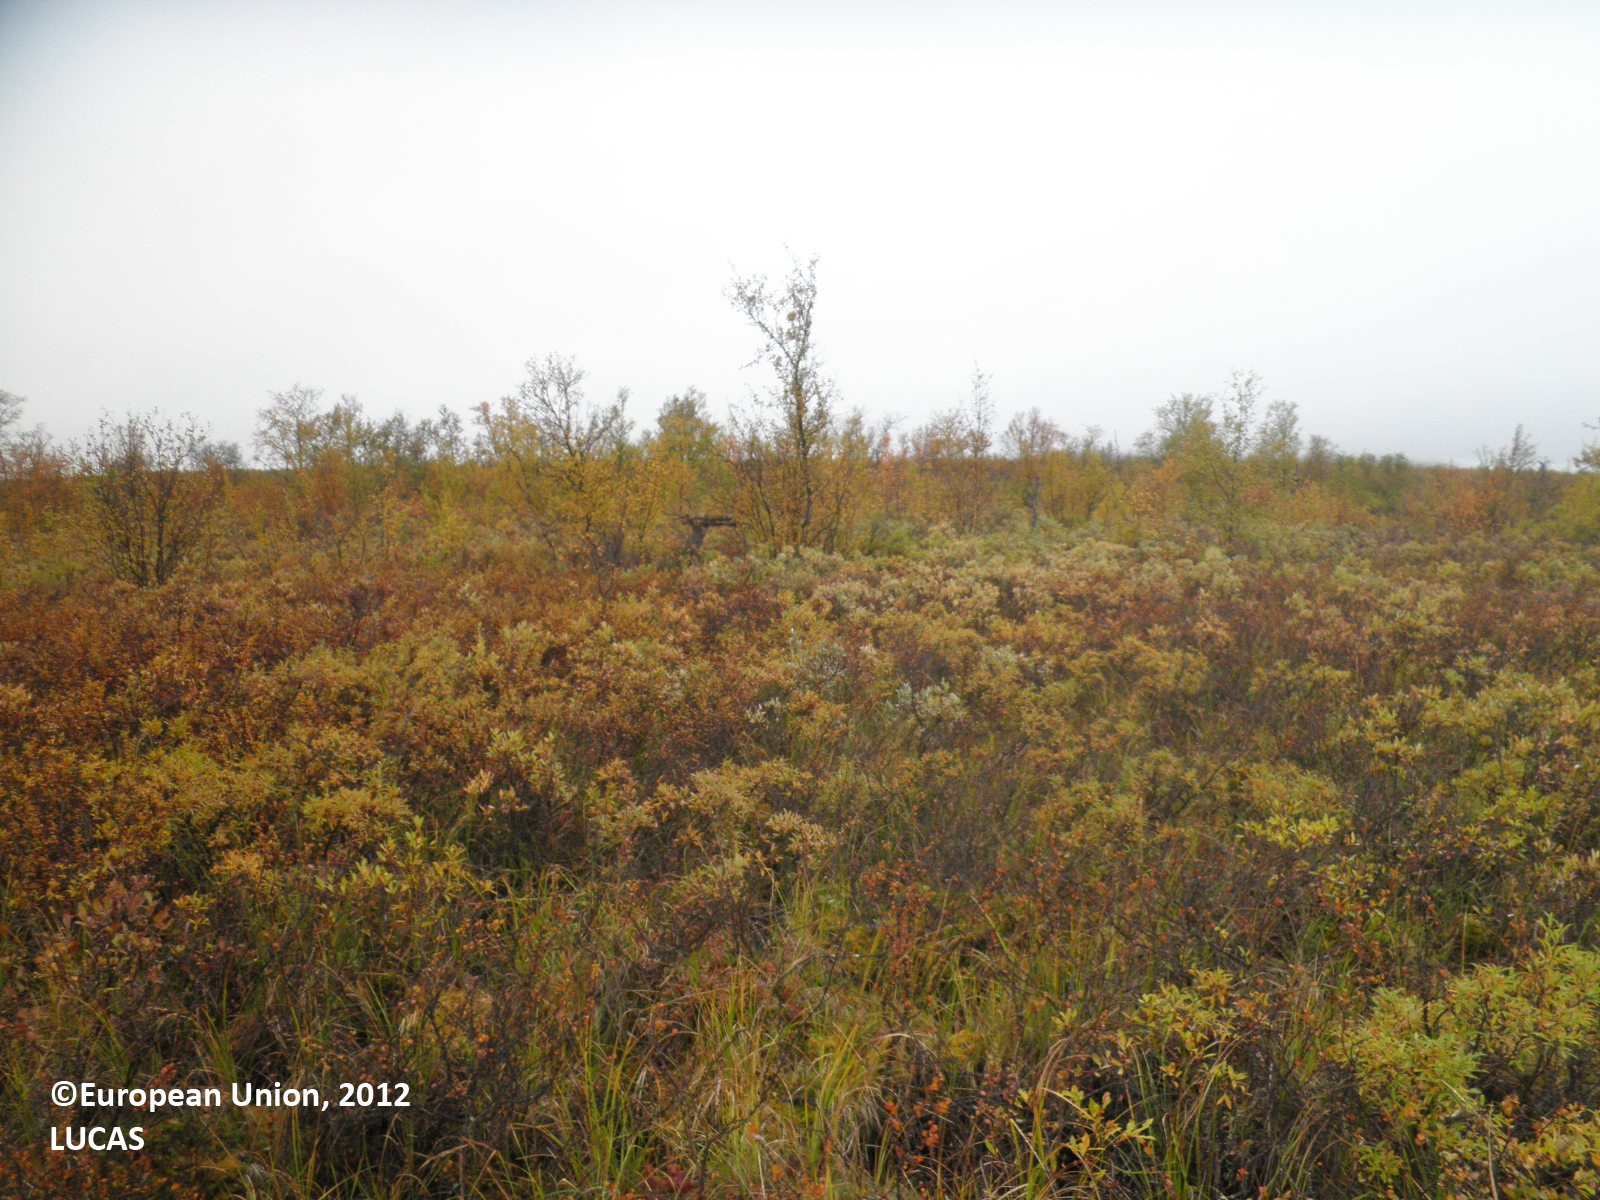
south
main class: Shrubland
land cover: Shrubland without tree cover
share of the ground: > 75 %
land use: Semi-natural and natural areas not in use
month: September
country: FI
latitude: 68.8188
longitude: 21.2137
